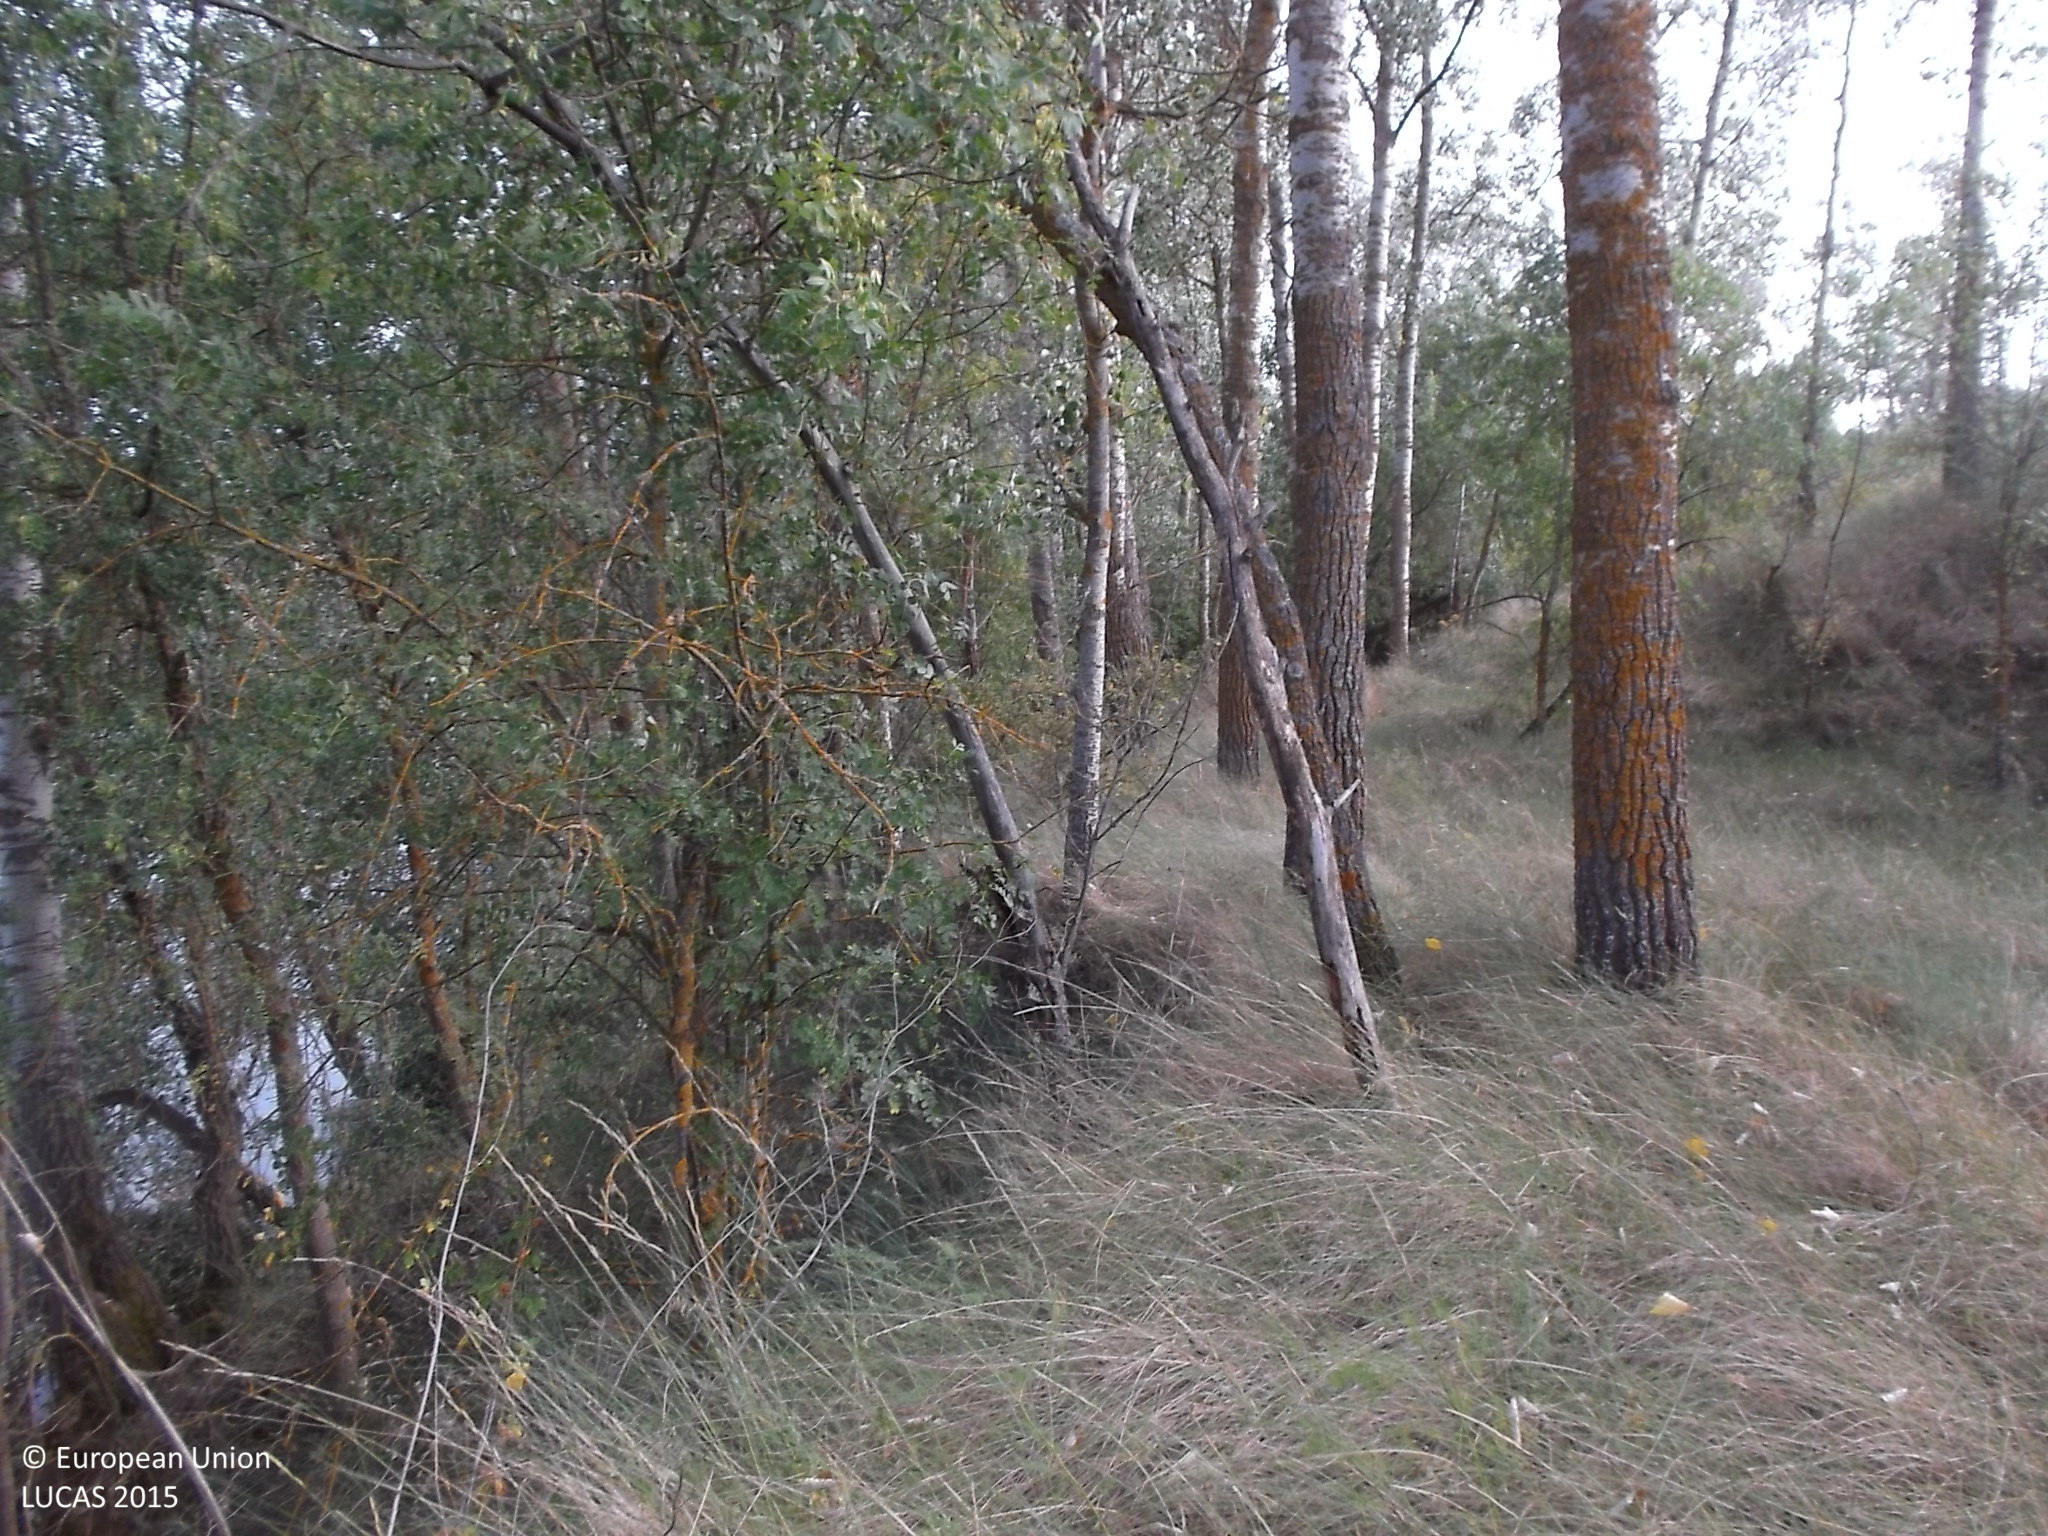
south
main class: Woodland
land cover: Broadleaved woodland
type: thermophilous deciduous forest
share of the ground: 50 - 75 %
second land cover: Grassland without tree/shrub cover
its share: 25 - 50 %
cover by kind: broadleaved forest trees 60 %, herbaceous plants 40 %
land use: Forestry
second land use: Agriculture (excluding fallow land and kitchen gardens)
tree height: > 5 m
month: July
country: ES
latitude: 41.4828
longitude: -5.8858
